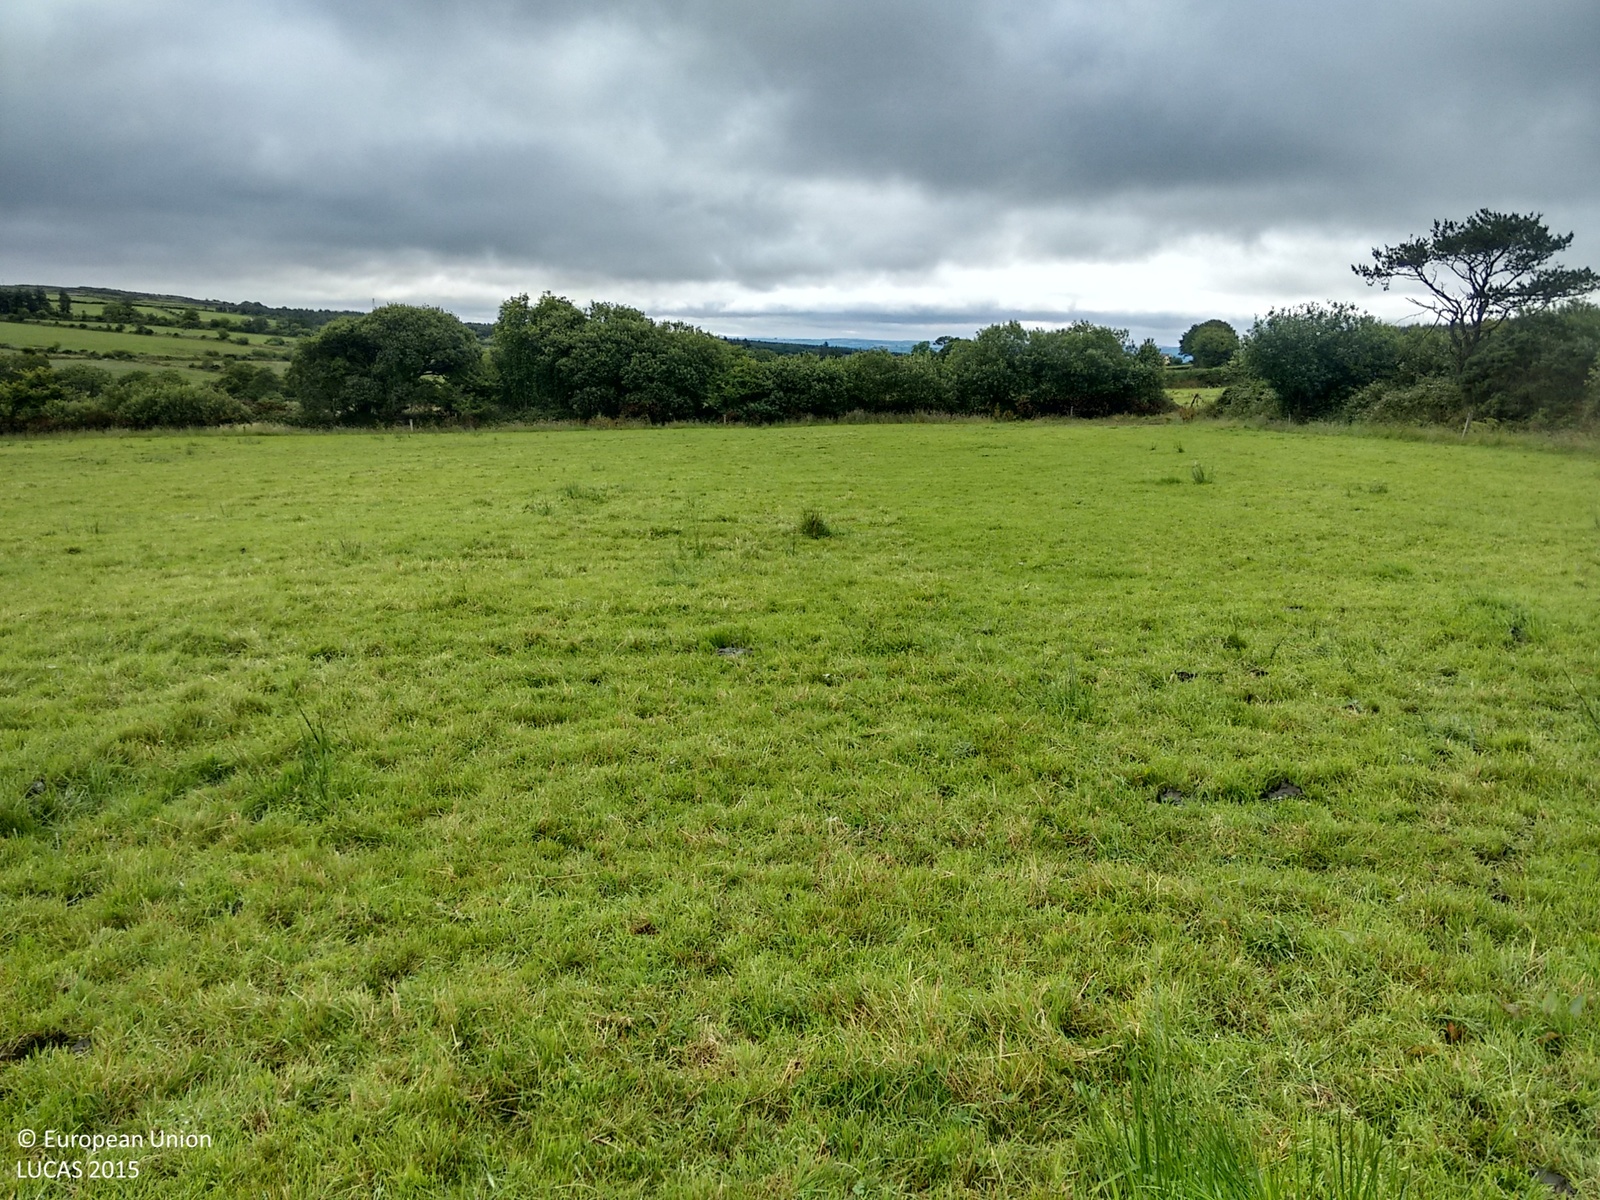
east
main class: Grassland
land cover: Grassland without tree/shrub cover
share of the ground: > 75 %
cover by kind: herbaceous plants 100 %
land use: Agriculture (excluding fallow land and kitchen gardens)
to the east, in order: Grassland without tree/shrub cover; Fences; Managed hedges; Ditches and canals; Fences; Grassland without tree/shrub cover; Fences; Managed hedges; Grassland without tree/shrub cover; Fences; Ditches and canals; Managed hedges; Fences; Grassland without tree/shrub cover
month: July
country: IE
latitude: 52.0859
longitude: -8.3885
